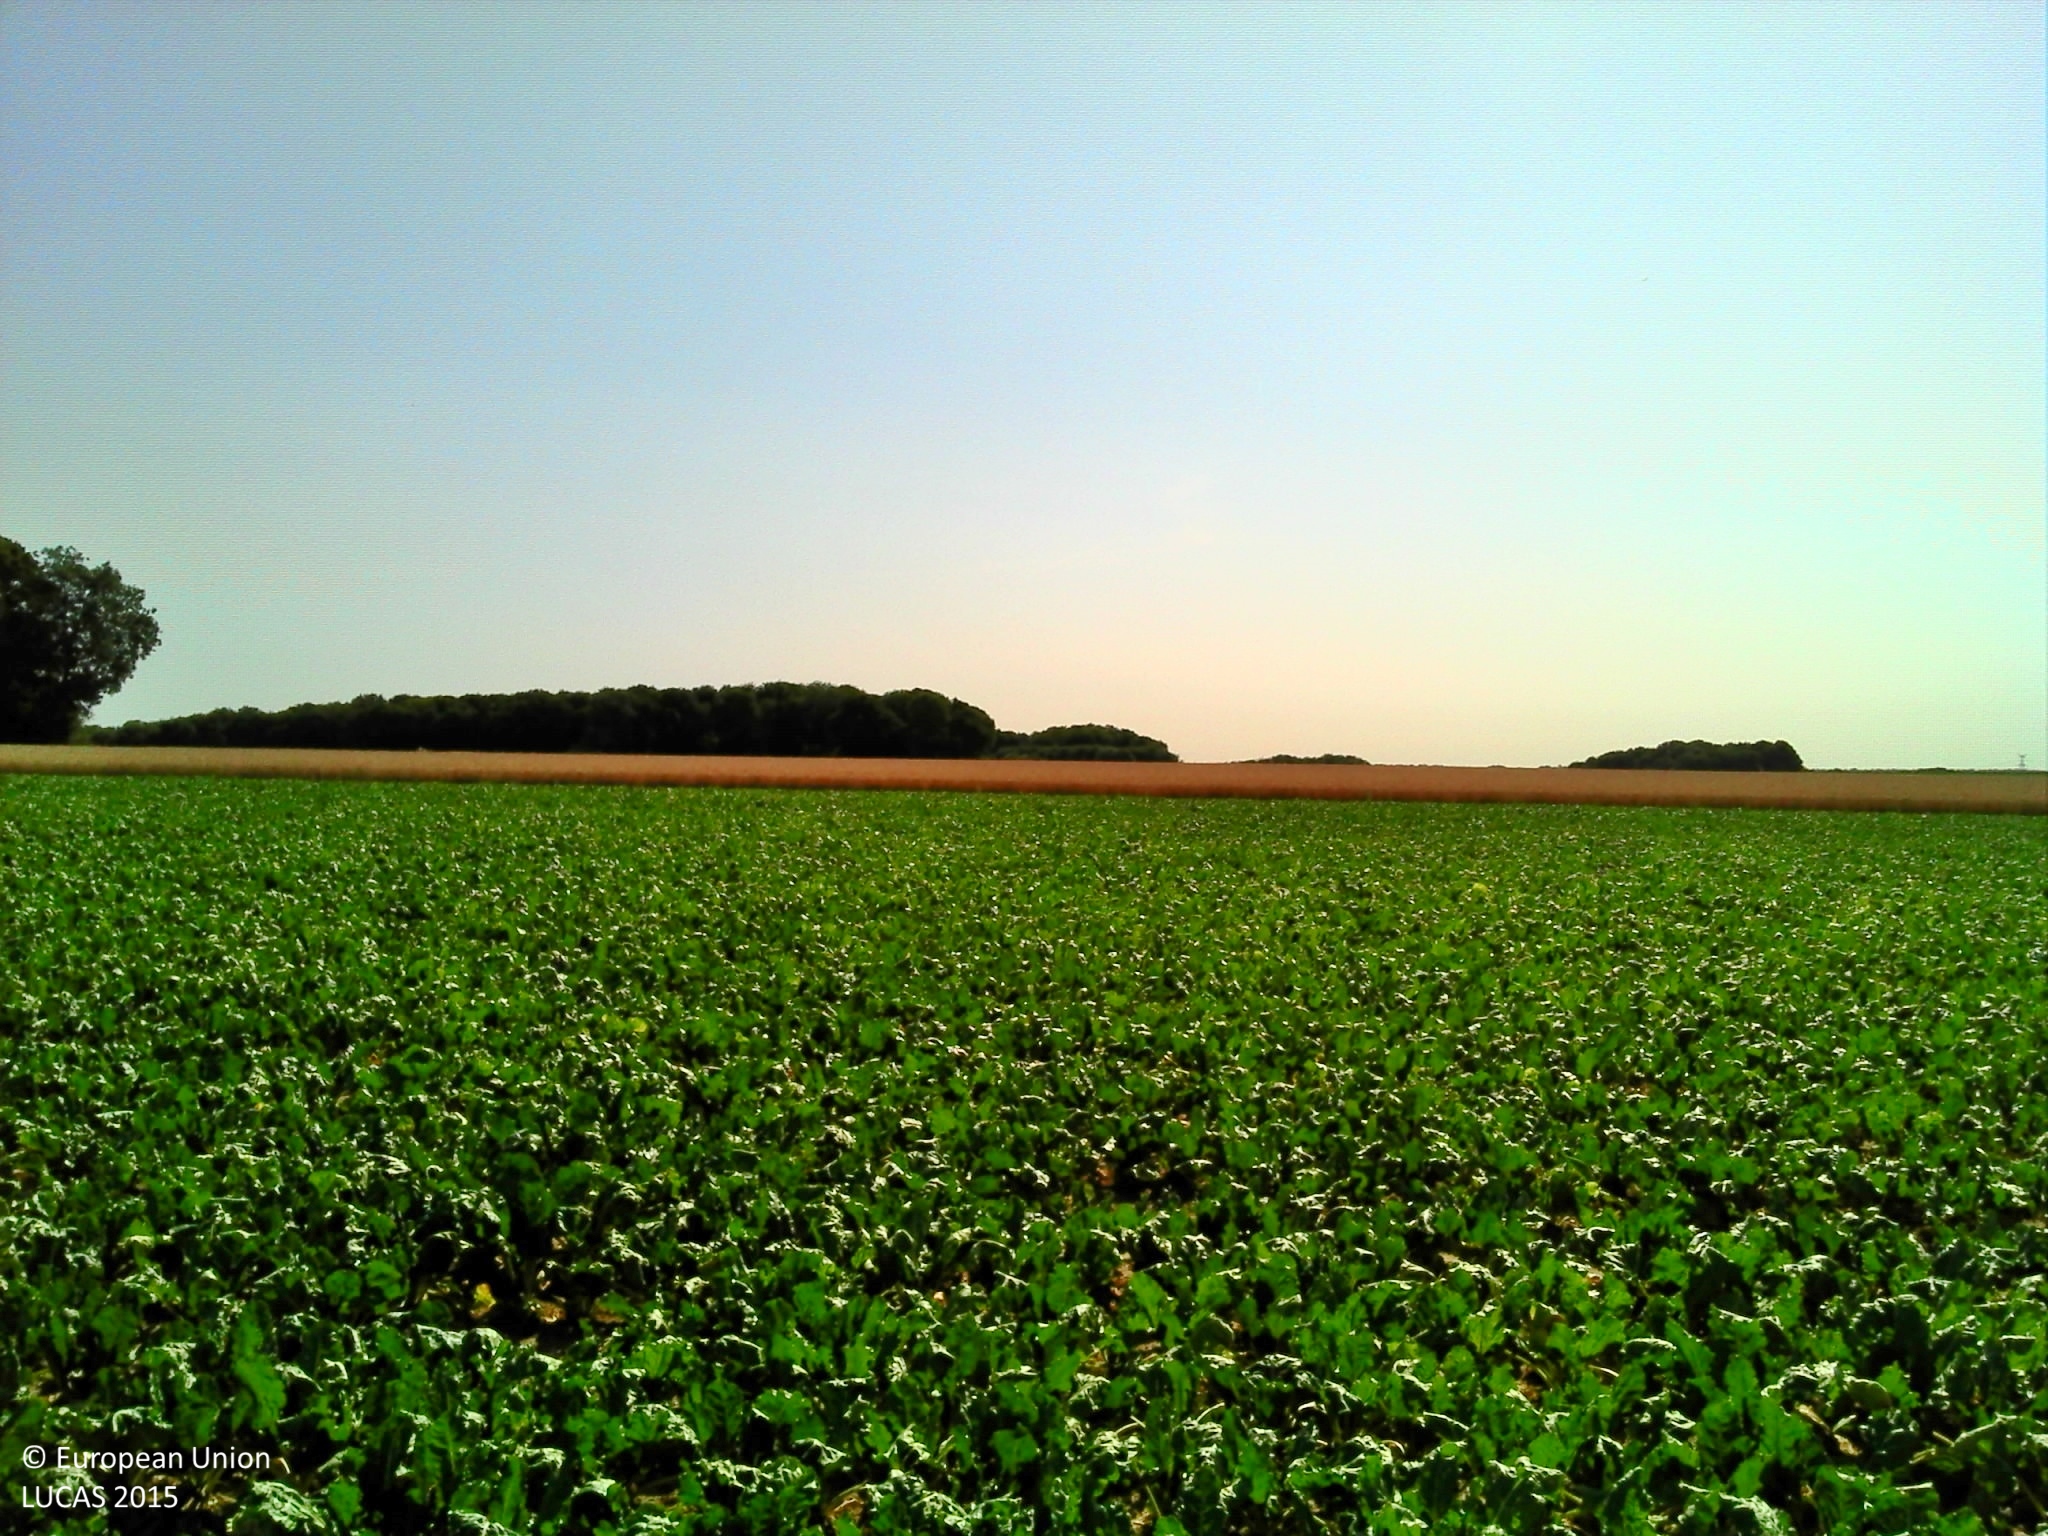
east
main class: Cropland
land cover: Sugar beet
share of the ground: > 75 %
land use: Agriculture (excluding fallow land and kitchen gardens)
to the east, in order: Sugar beet; Ditches and canals; Common wheat; Ditches and canals; Sugar beet
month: July
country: FR
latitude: 49.2538
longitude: 2.2794
